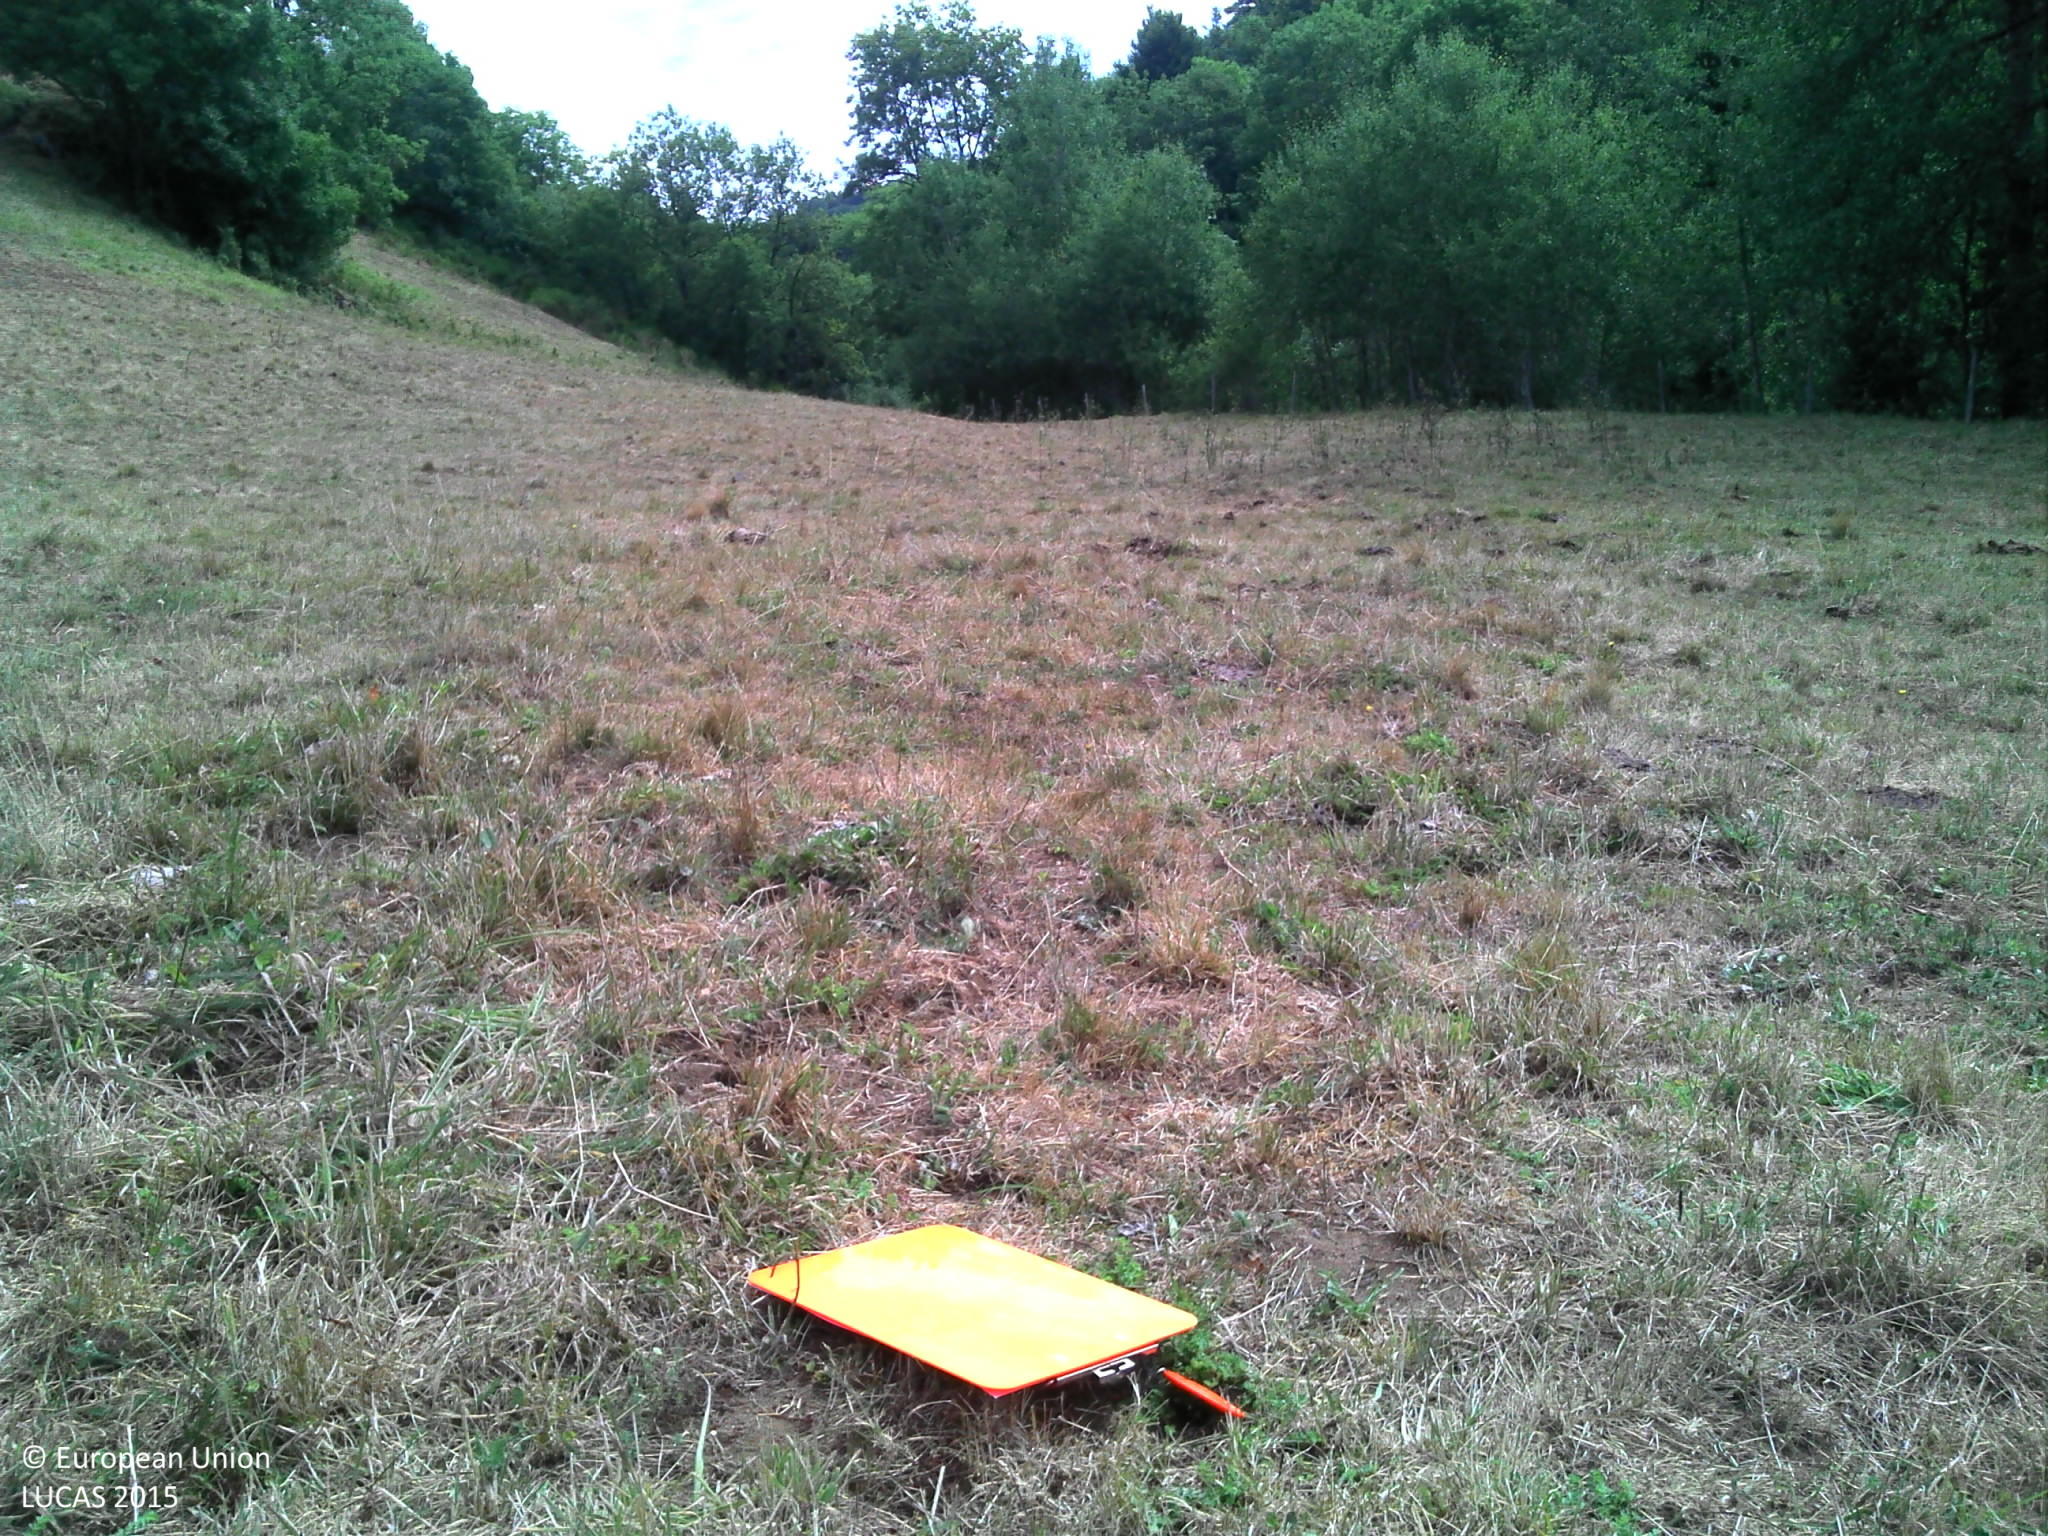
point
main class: Grassland
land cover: Grassland without tree/shrub cover
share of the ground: > 75 %
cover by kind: herbaceous plants 100 %
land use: Agriculture (excluding fallow land and kitchen gardens)
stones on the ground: < 10 %
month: July
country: FR
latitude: 44.7319
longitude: 3.9063
